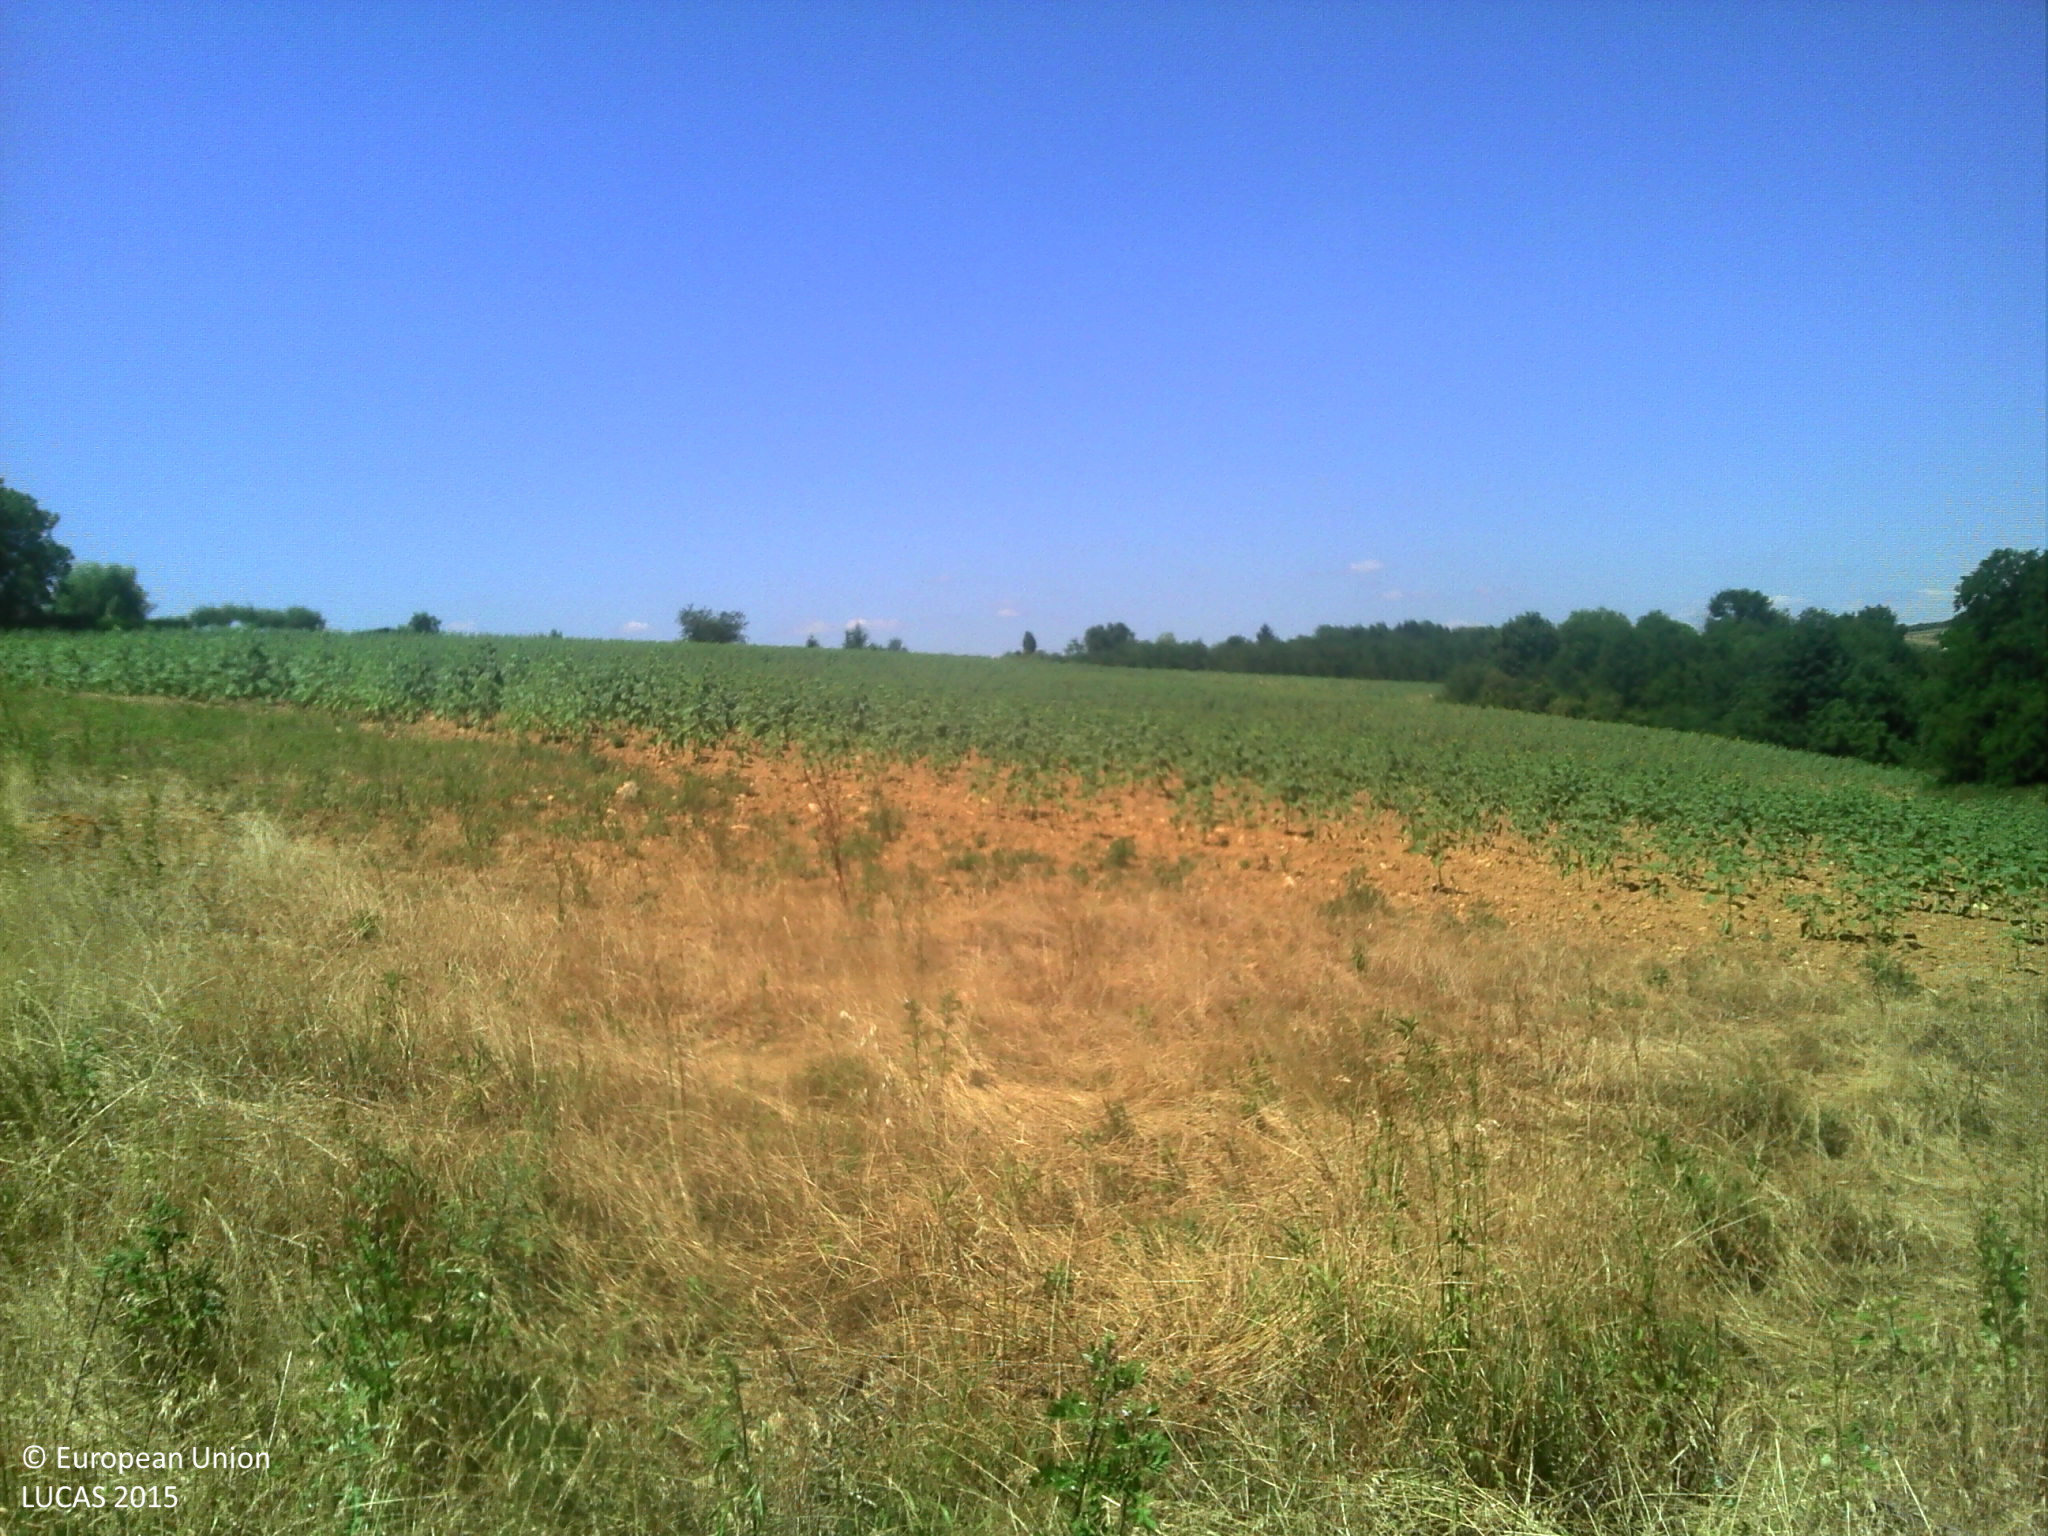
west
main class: Woodland
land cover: Broadleaved woodland
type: mesophytic deciduous forest
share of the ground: > 75 %
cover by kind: broadleaved forest trees 90 %, herbaceous plants 10 %
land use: Forestry
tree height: > 5 m
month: July
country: FR
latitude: 45.5601
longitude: 4.8668
